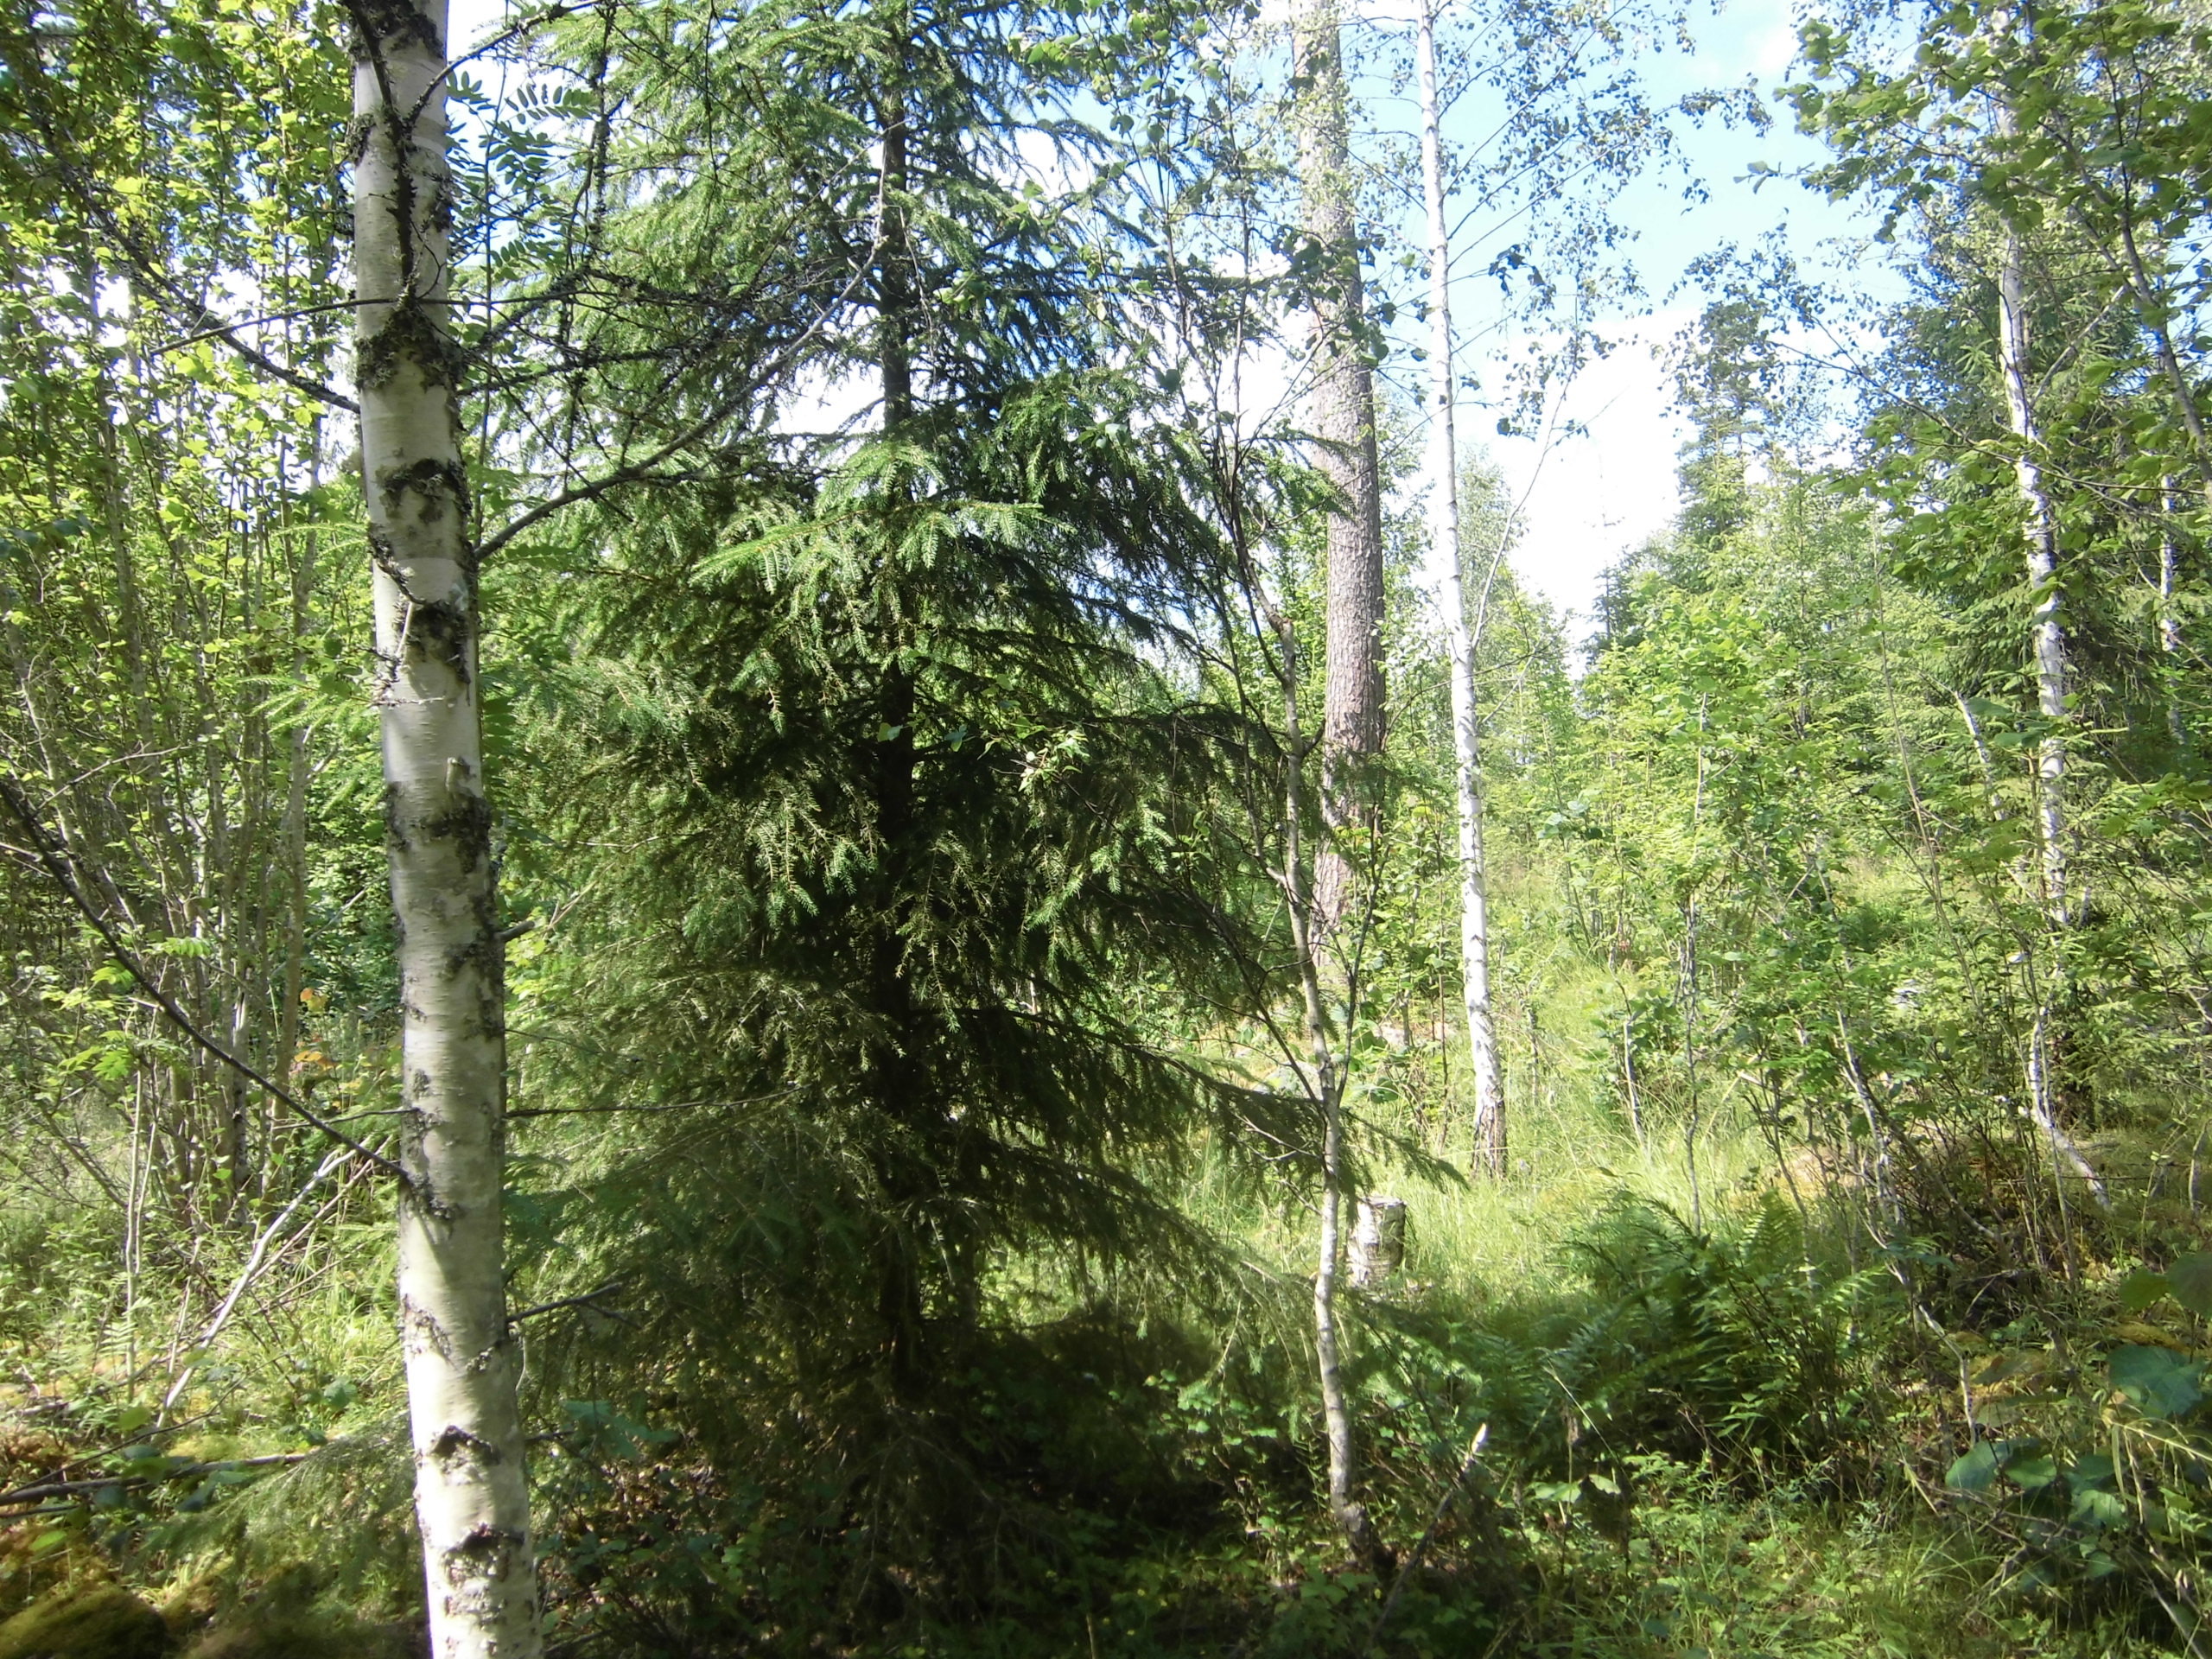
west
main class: Woodland
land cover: Spruce dominated mixed woodland
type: boreal forest
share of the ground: 50 - 75 %
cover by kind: broadleaved forest trees 35 %, coniferous forest trees 25 %, shrubs 15 %, herbaceous plants 15 %, lichens and mosses 10 %
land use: Forestry
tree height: > 5 m
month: July
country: SE
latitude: 57.1679
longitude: 15.5376
